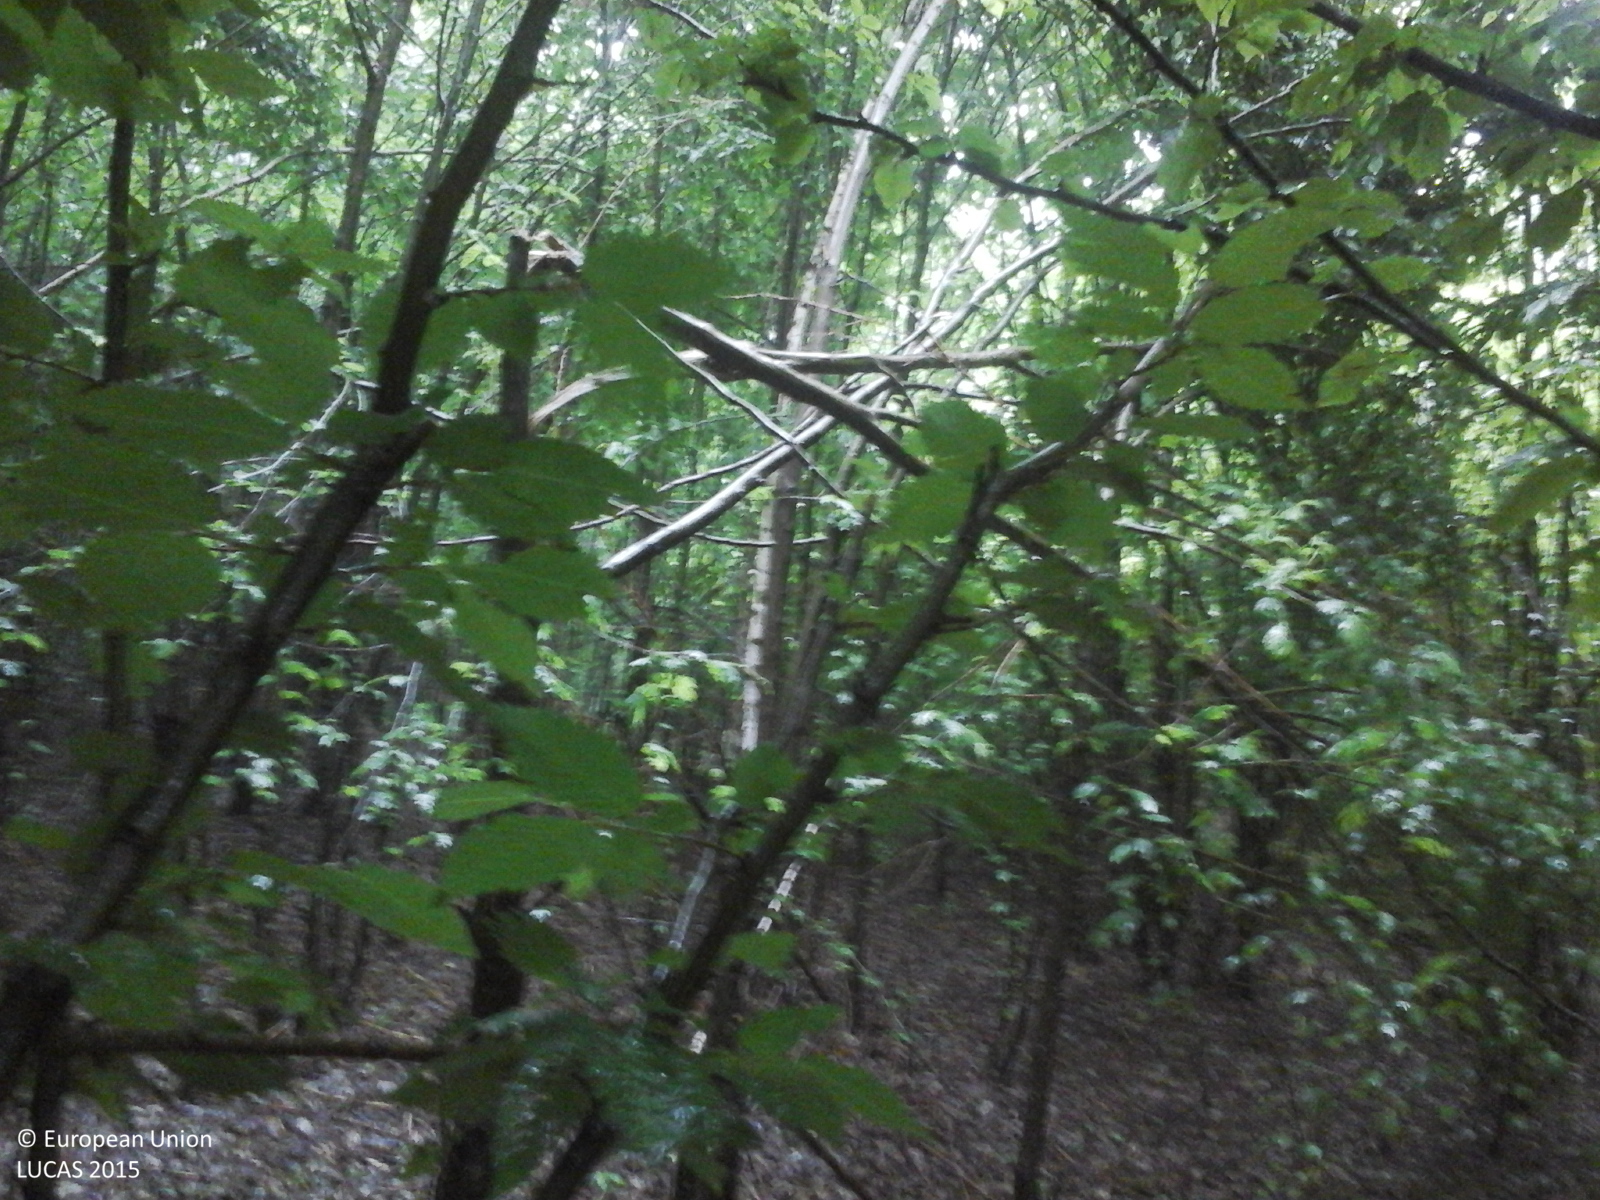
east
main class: Woodland
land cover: Broadleaved woodland
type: beech forest
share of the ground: > 75 %
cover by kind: broadleaved forest trees 100 %
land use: Forestry
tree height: > 5 m
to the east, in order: Broadleaved woodland; Grassland without tree/shrub cover; Ditches and canals; Tracks; Grassland without tree/shrub cover; Broadleaved woodland; Tracks; Broadleaved woodland
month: May
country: RO
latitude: 45.8070
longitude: 25.3219
